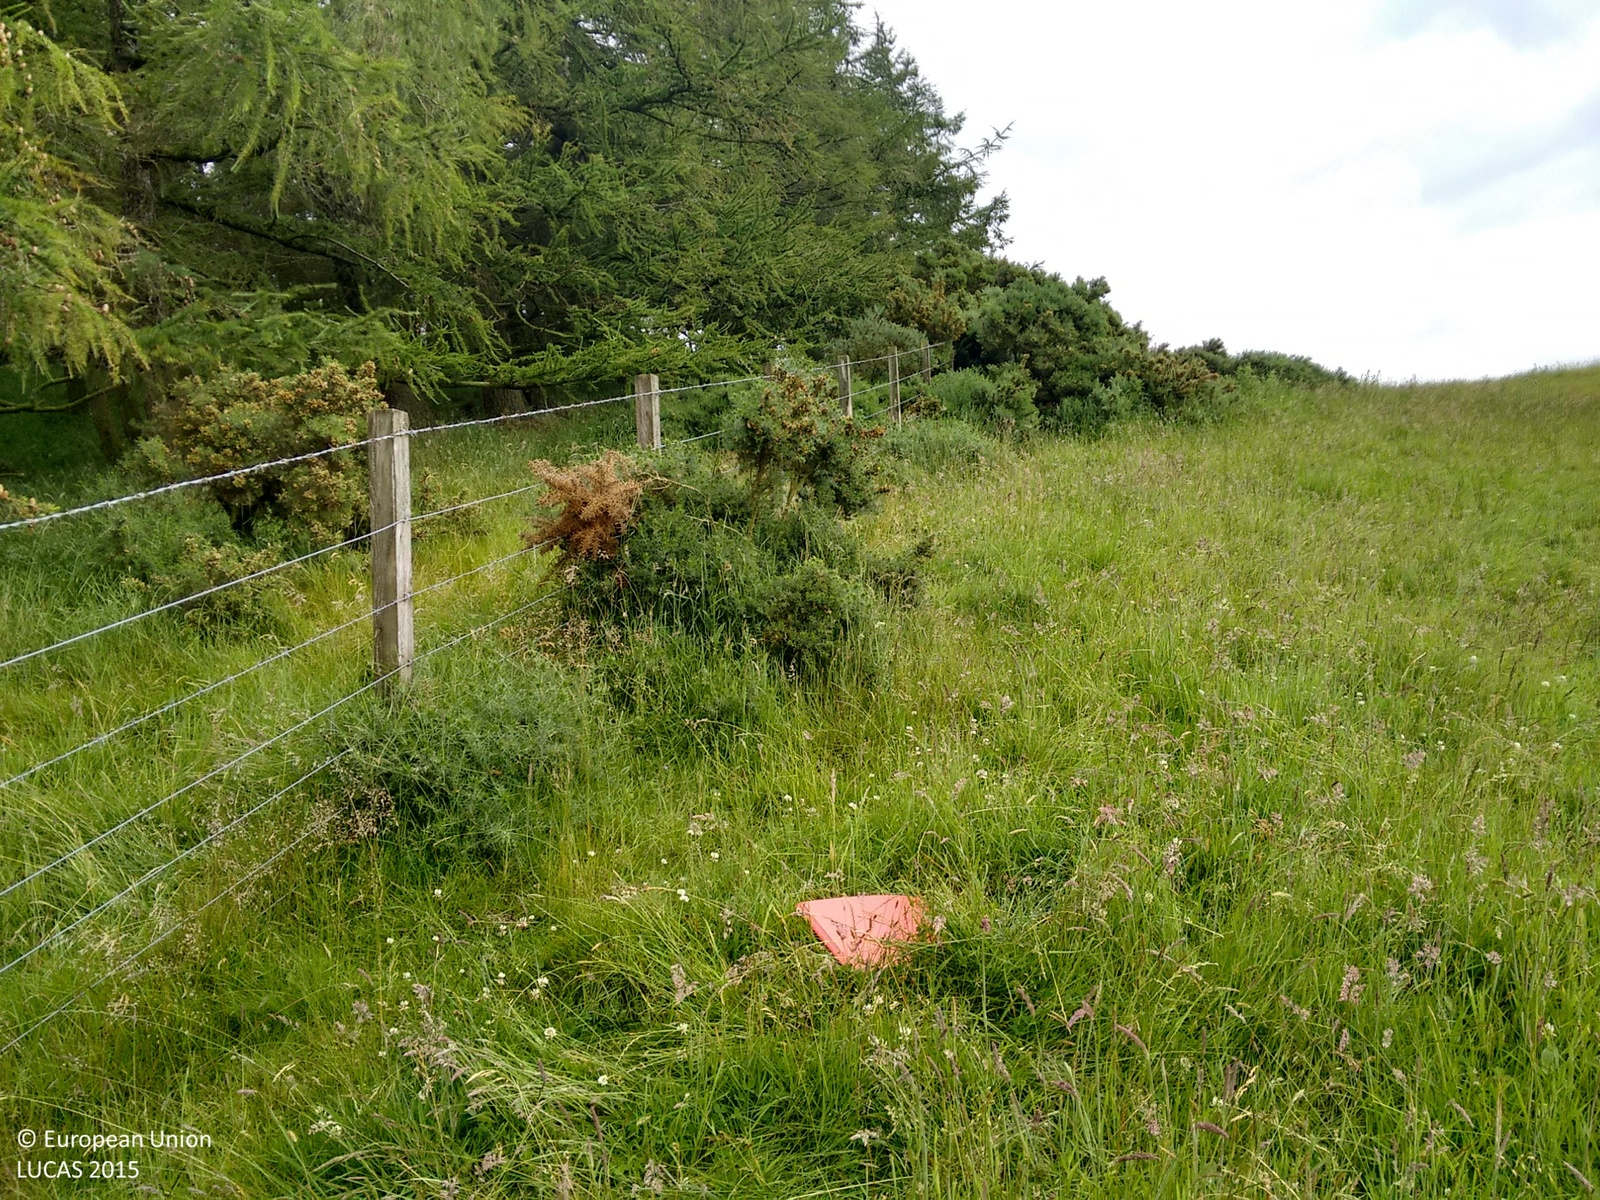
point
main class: Grassland
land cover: Grassland without tree/shrub cover
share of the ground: > 75 %
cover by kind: herbaceous plants 95 %, shrubs 5 %
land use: Agriculture (excluding fallow land and kitchen gardens)
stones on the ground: < 10 %
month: July
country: GB
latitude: 56.2464
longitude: -3.0587
